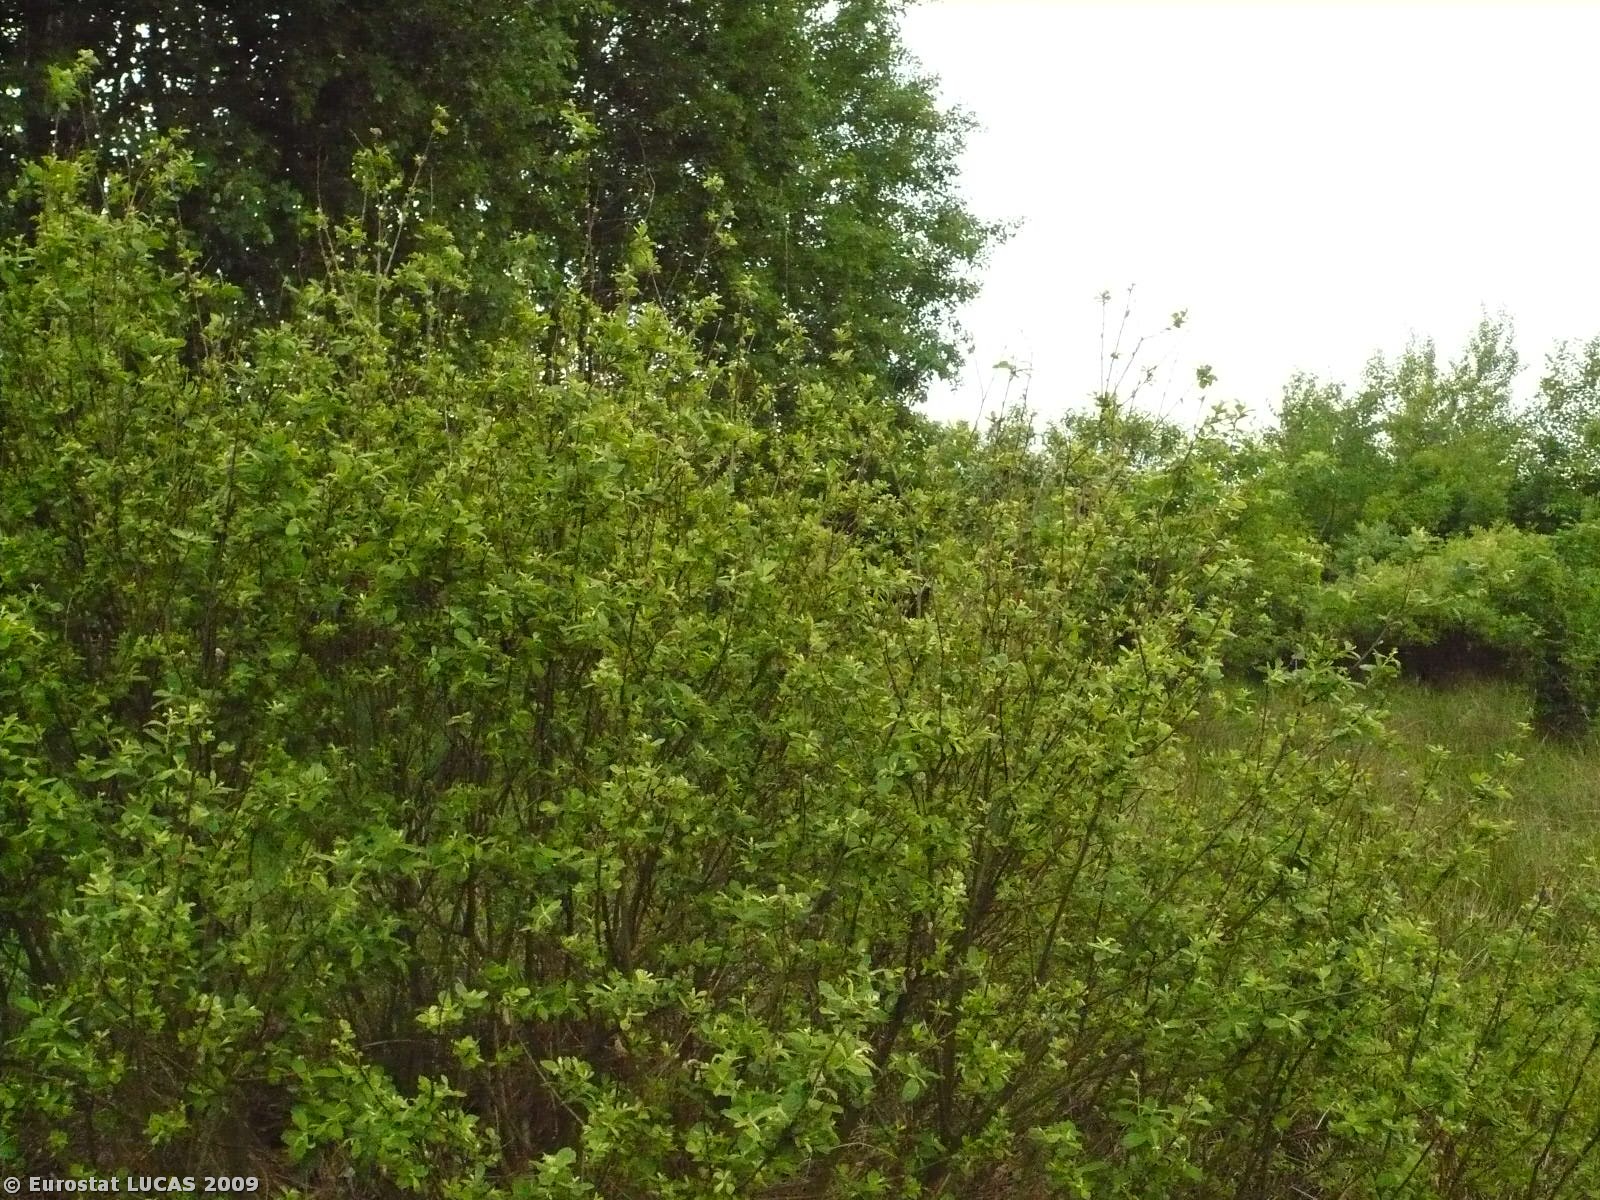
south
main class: Grassland
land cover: Grassland with sparse tree/shrub cover
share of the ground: > 75 %
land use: Unused
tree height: > 5 m
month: May
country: PL
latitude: 51.8089
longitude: 15.2975
